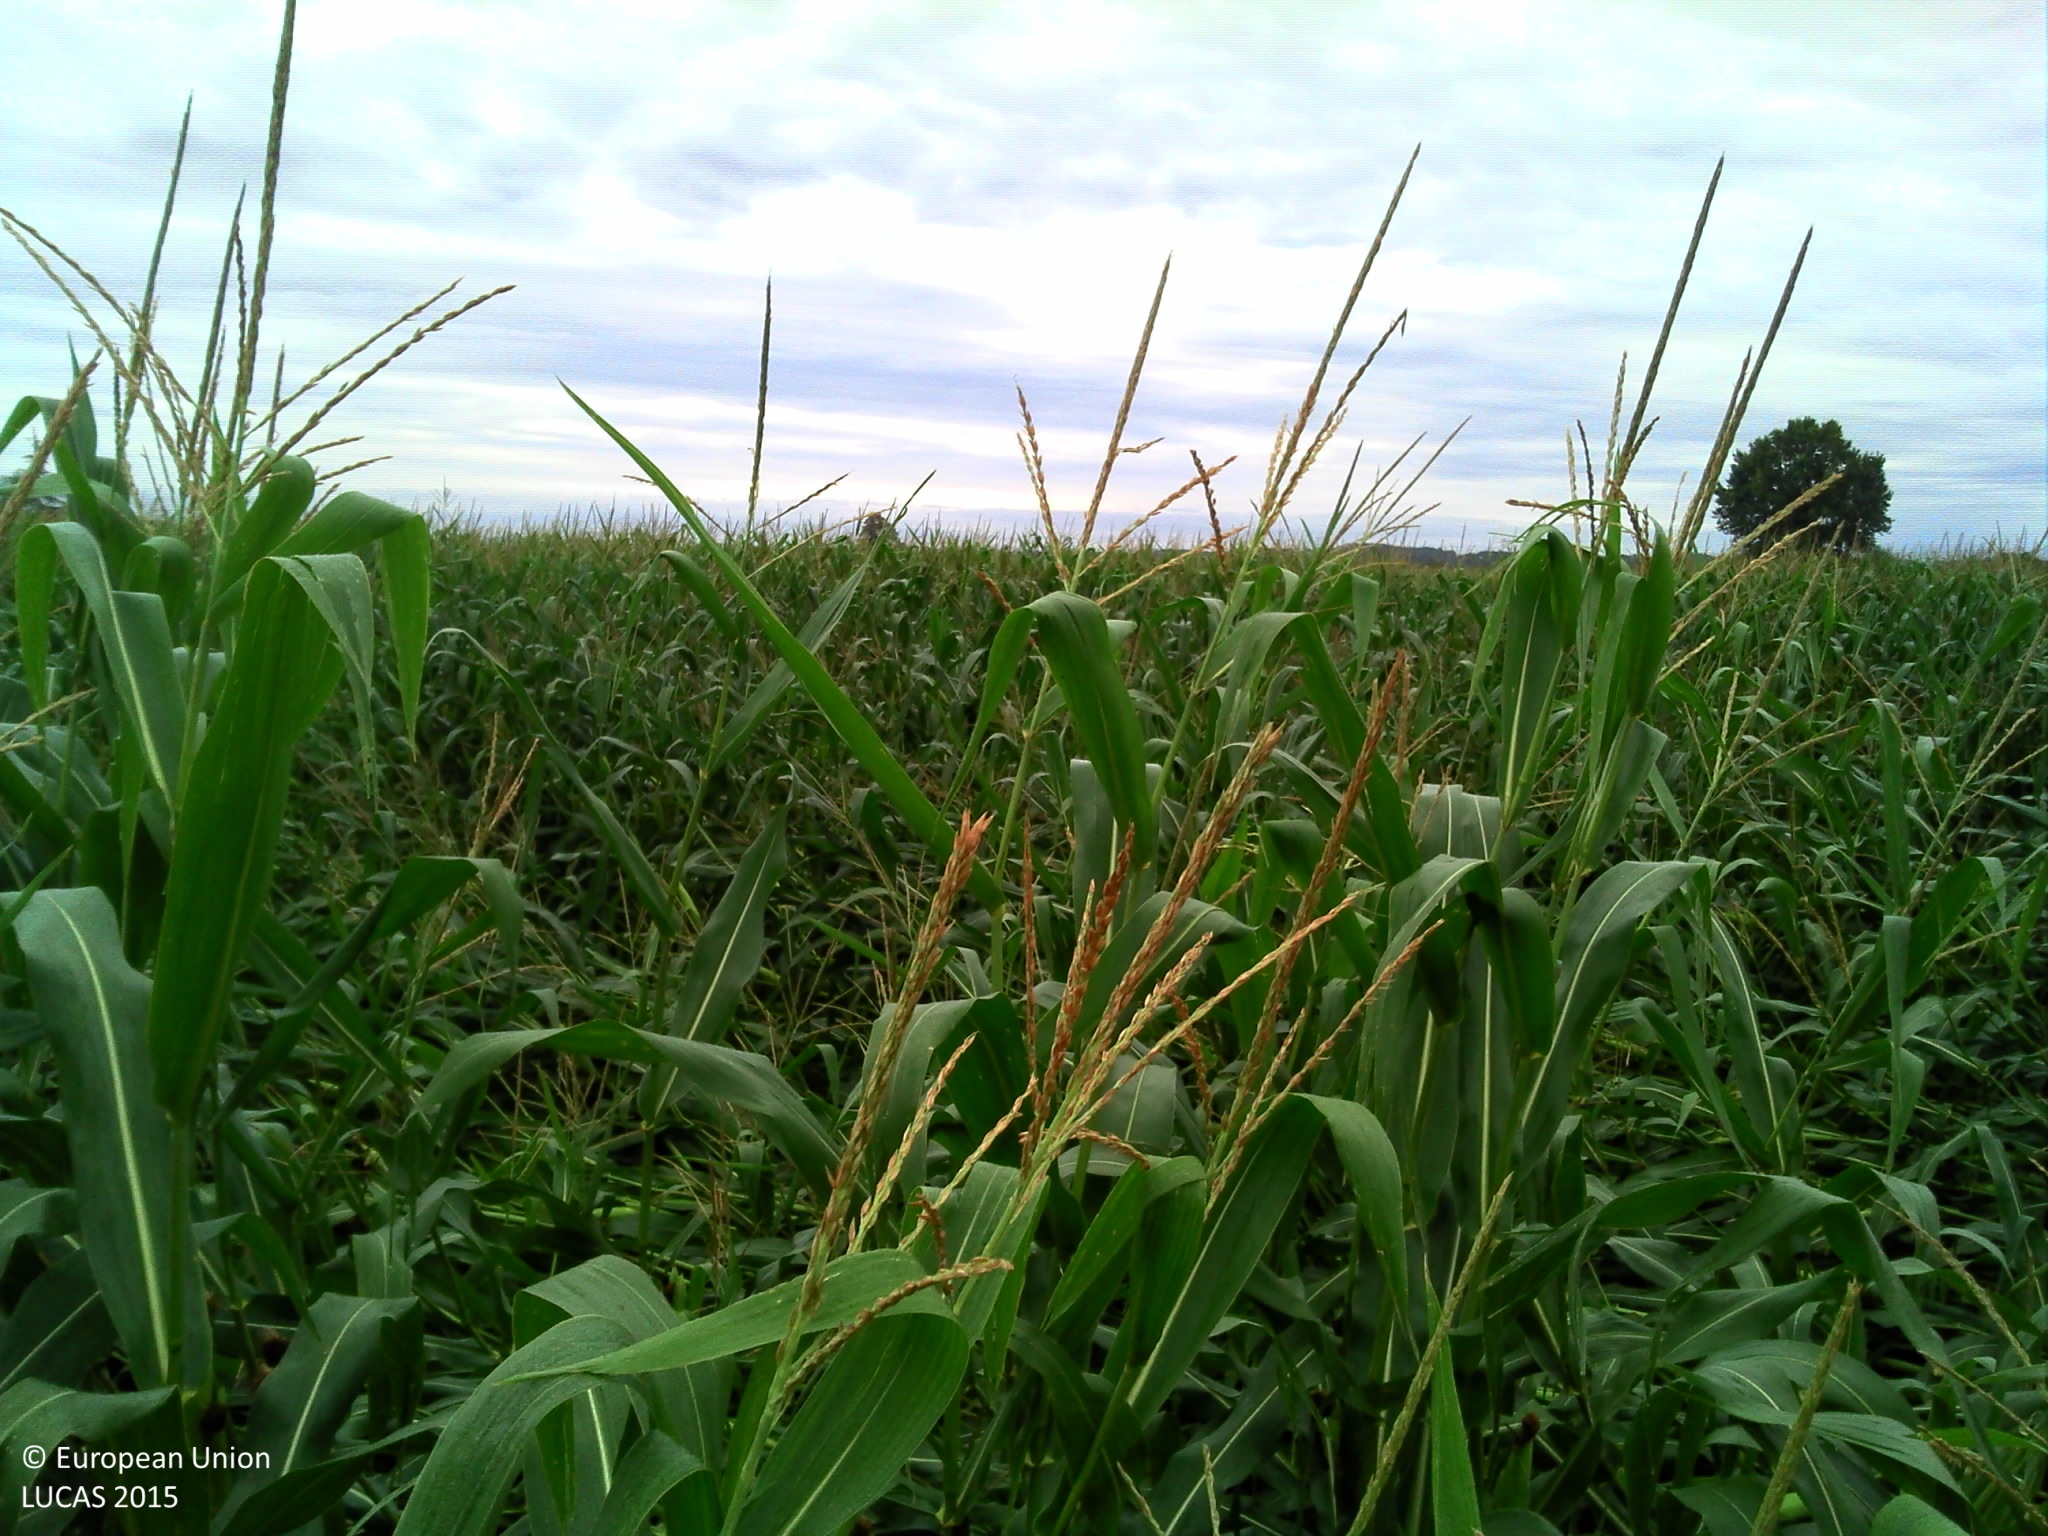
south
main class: Cropland
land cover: Maize
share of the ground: > 75 %
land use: Agriculture (excluding fallow land and kitchen gardens)
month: September
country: FR
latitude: 43.4706
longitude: -0.5040
